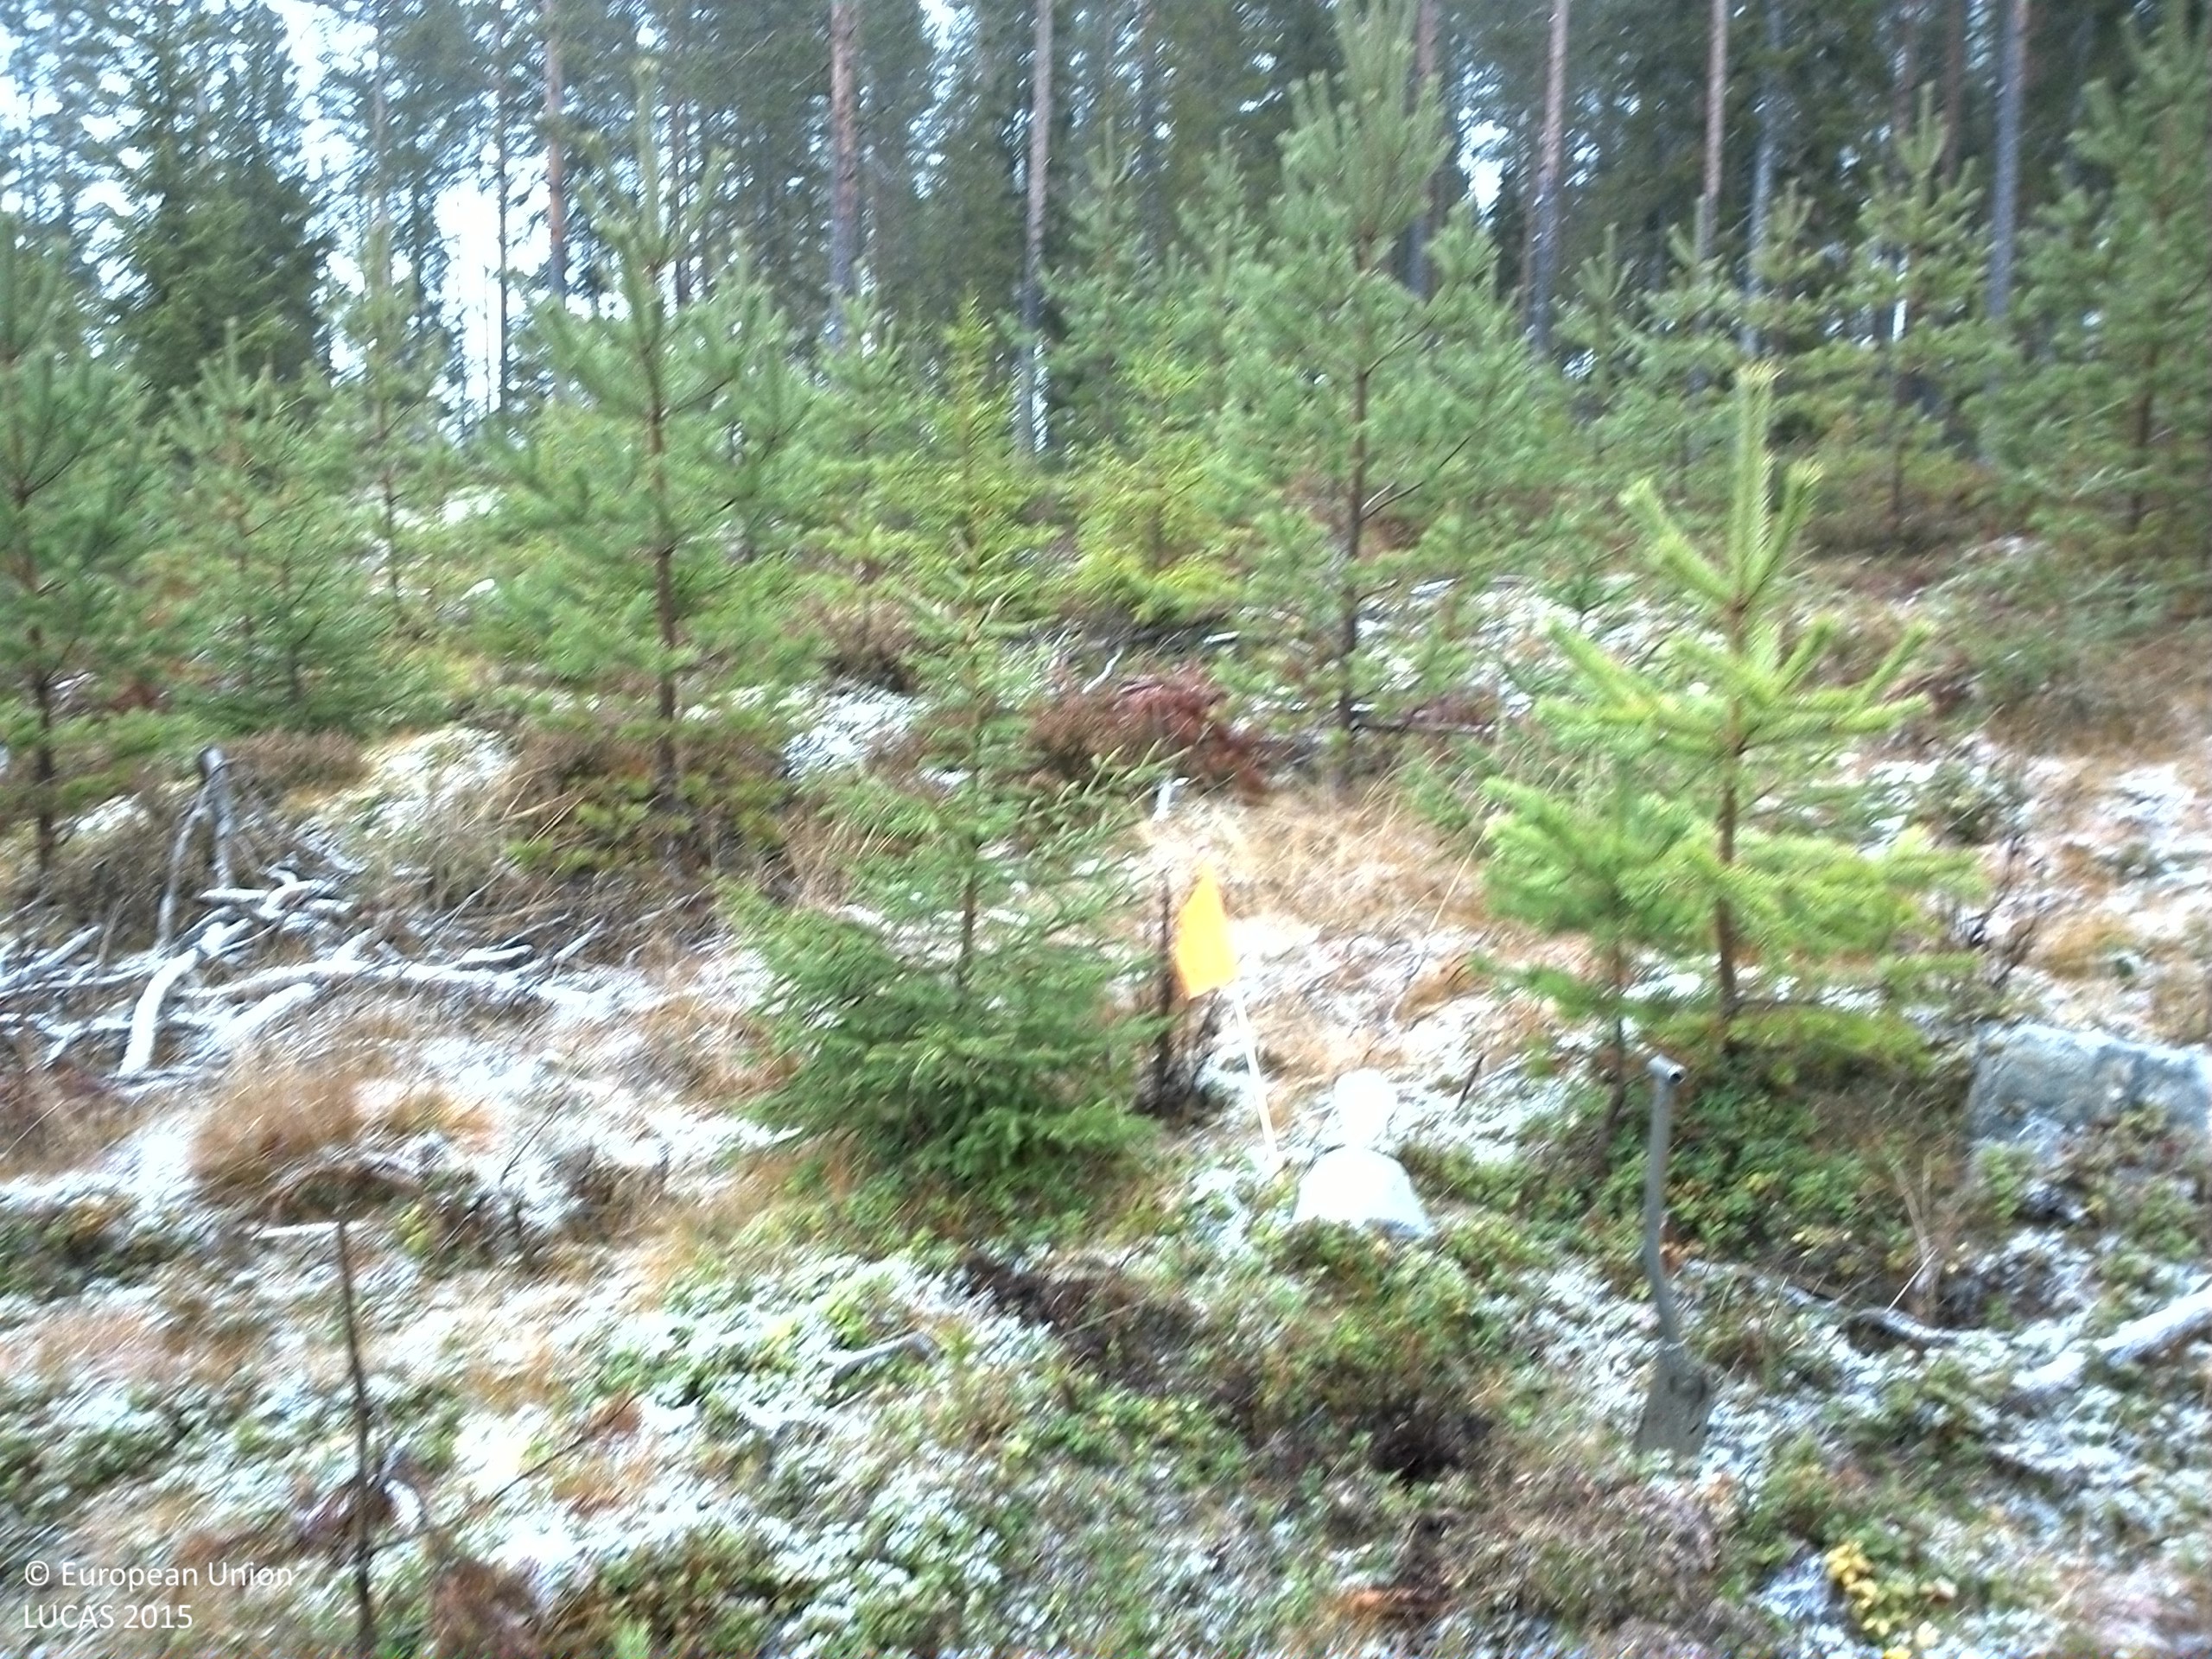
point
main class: Woodland
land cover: Other coniferous woodland
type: boreal forest
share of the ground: 50 - 75 %
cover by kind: coniferous forest trees 65 %, shrubs 15 %, herbaceous plants 10 %, broadleaved forest trees 5 %, consolidated bare surface 5 %
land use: Forestry
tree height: < 5 m
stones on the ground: < 10 %
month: November
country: SE
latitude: 60.2959
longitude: 16.6293
